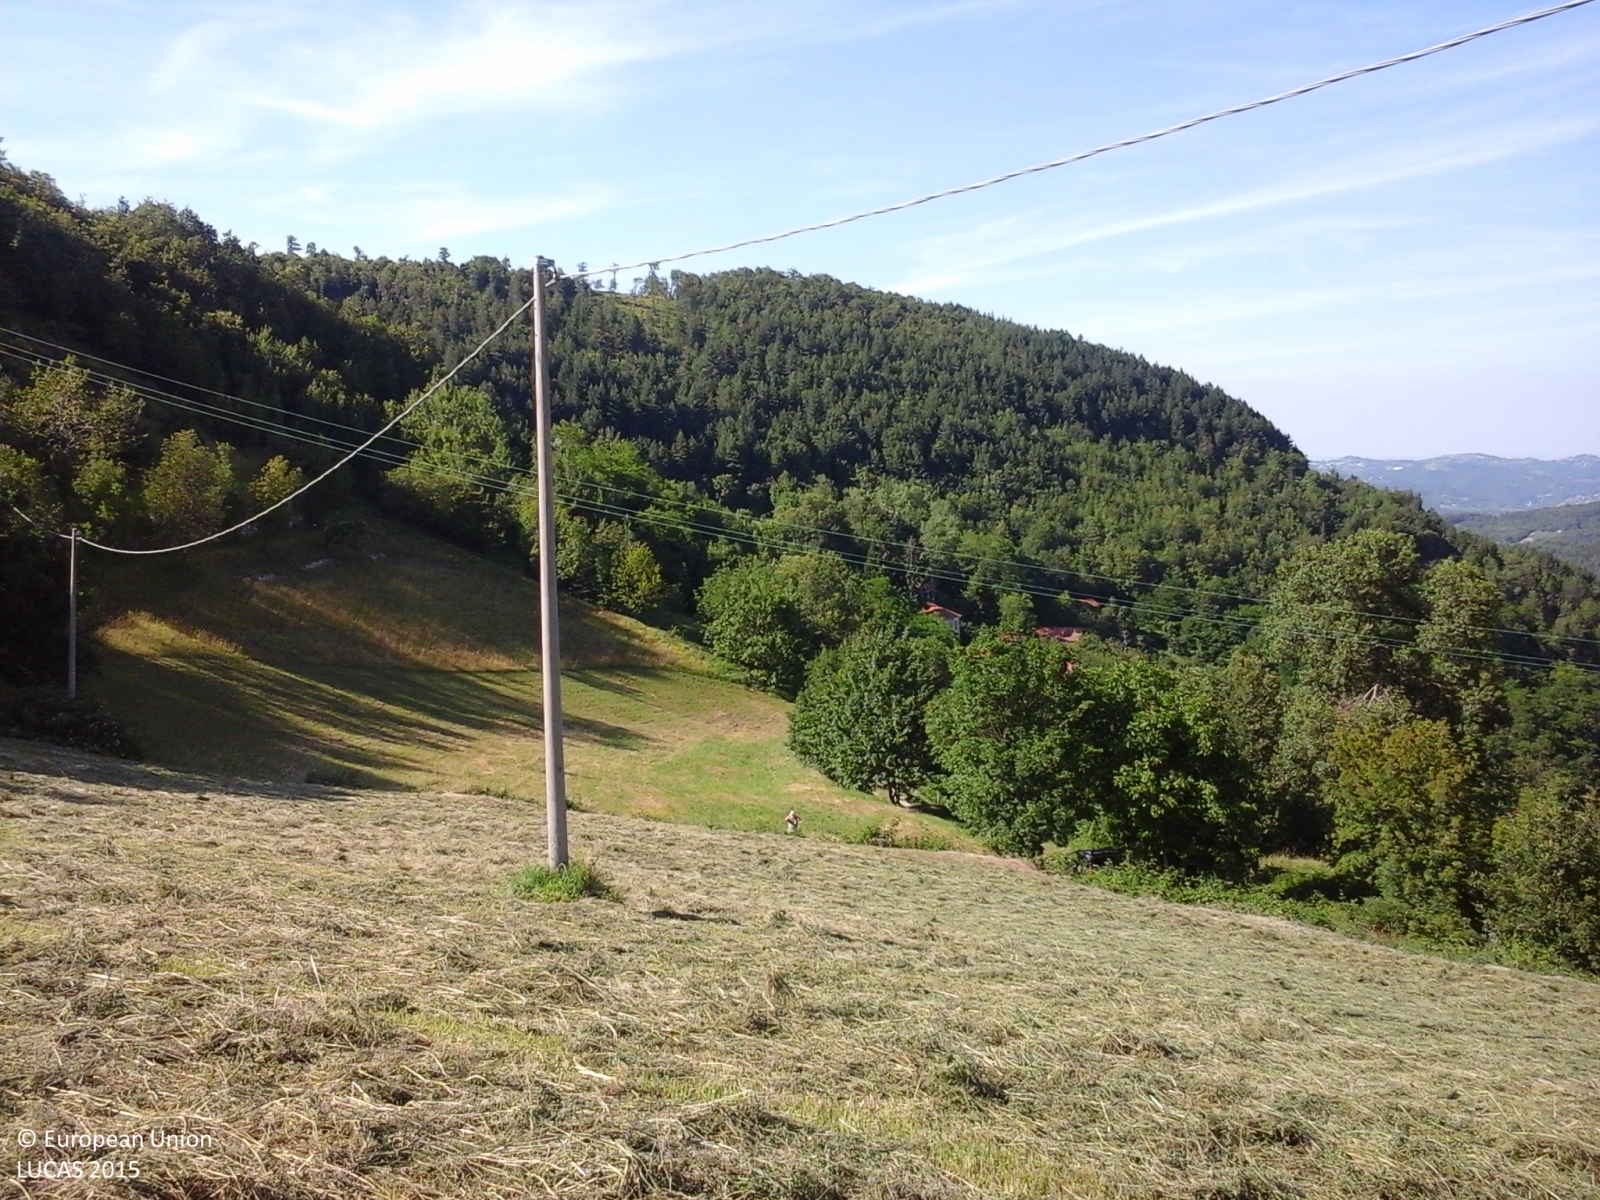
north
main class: Cropland
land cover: Lucerne
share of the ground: > 75 %
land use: Agriculture (excluding fallow land and kitchen gardens)
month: June
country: IT
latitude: 44.6073
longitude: 8.3025
